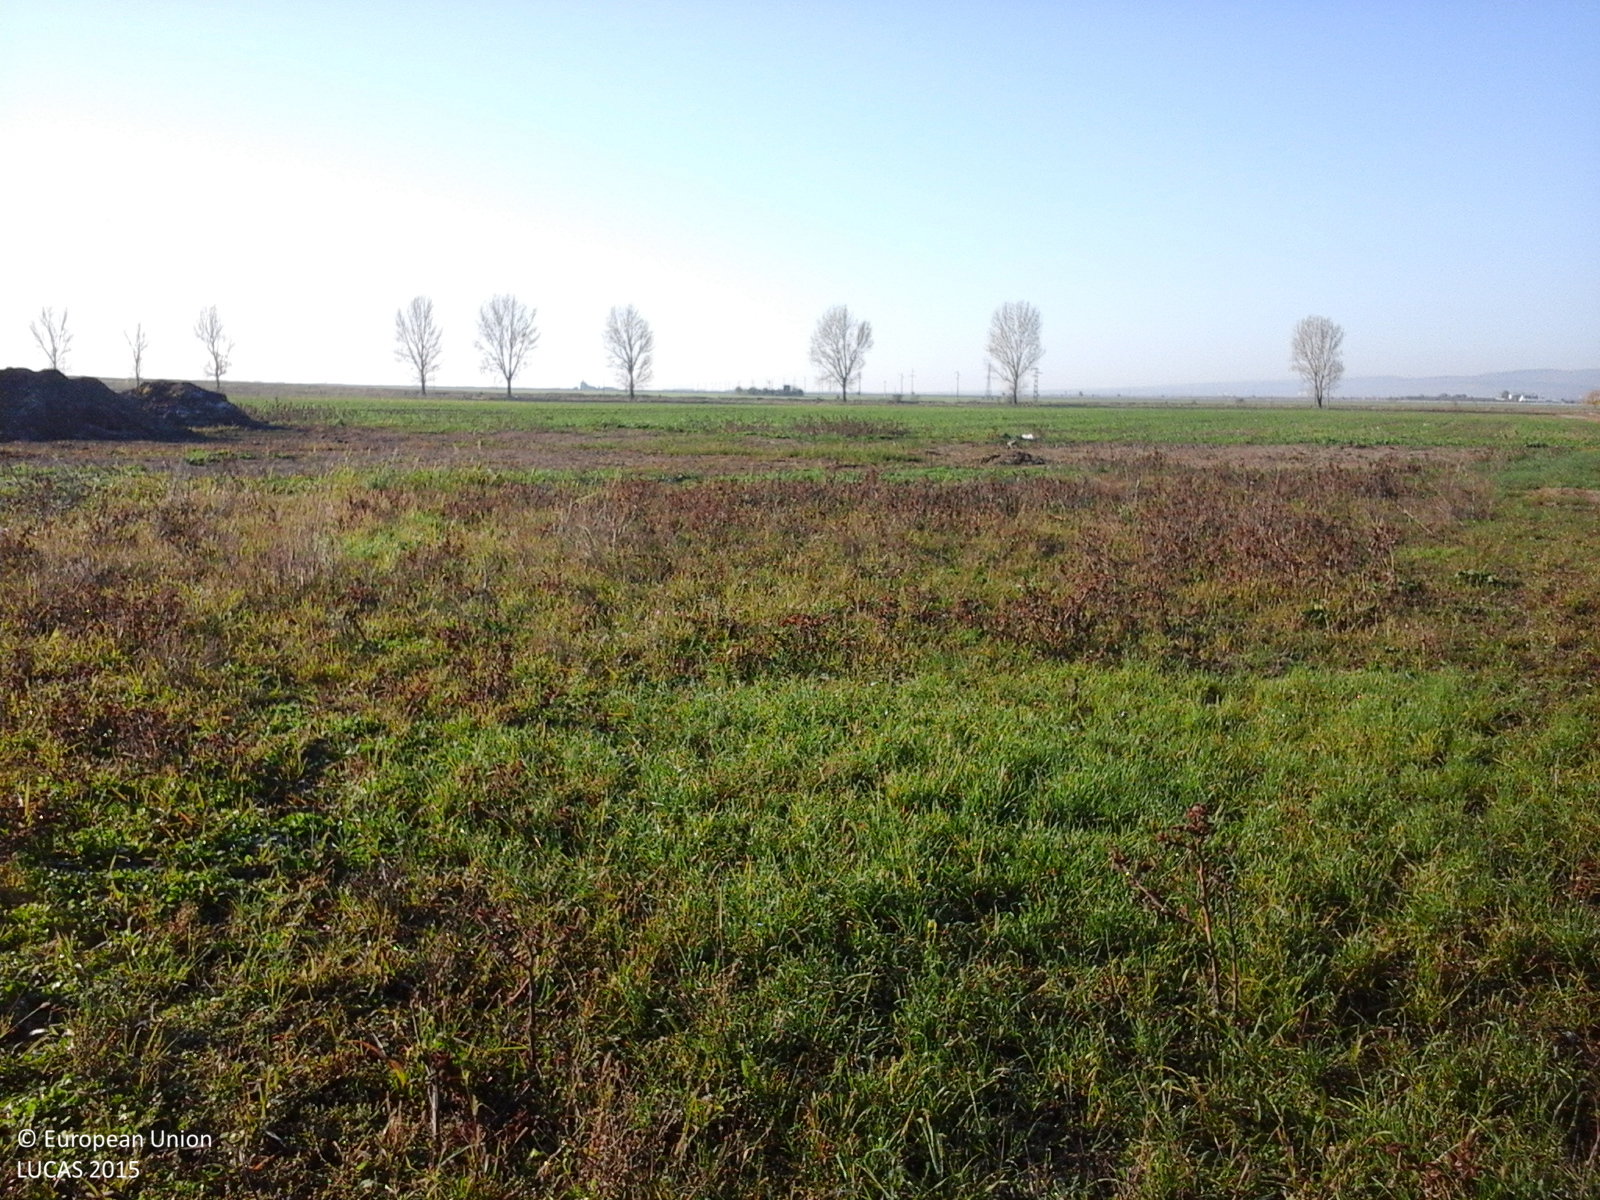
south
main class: Grassland
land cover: Grassland without tree/shrub cover
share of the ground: > 75 %
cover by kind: herbaceous plants 100 %
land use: Agriculture (excluding fallow land and kitchen gardens)
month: October
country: RO
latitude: 45.6348
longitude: 27.1419
